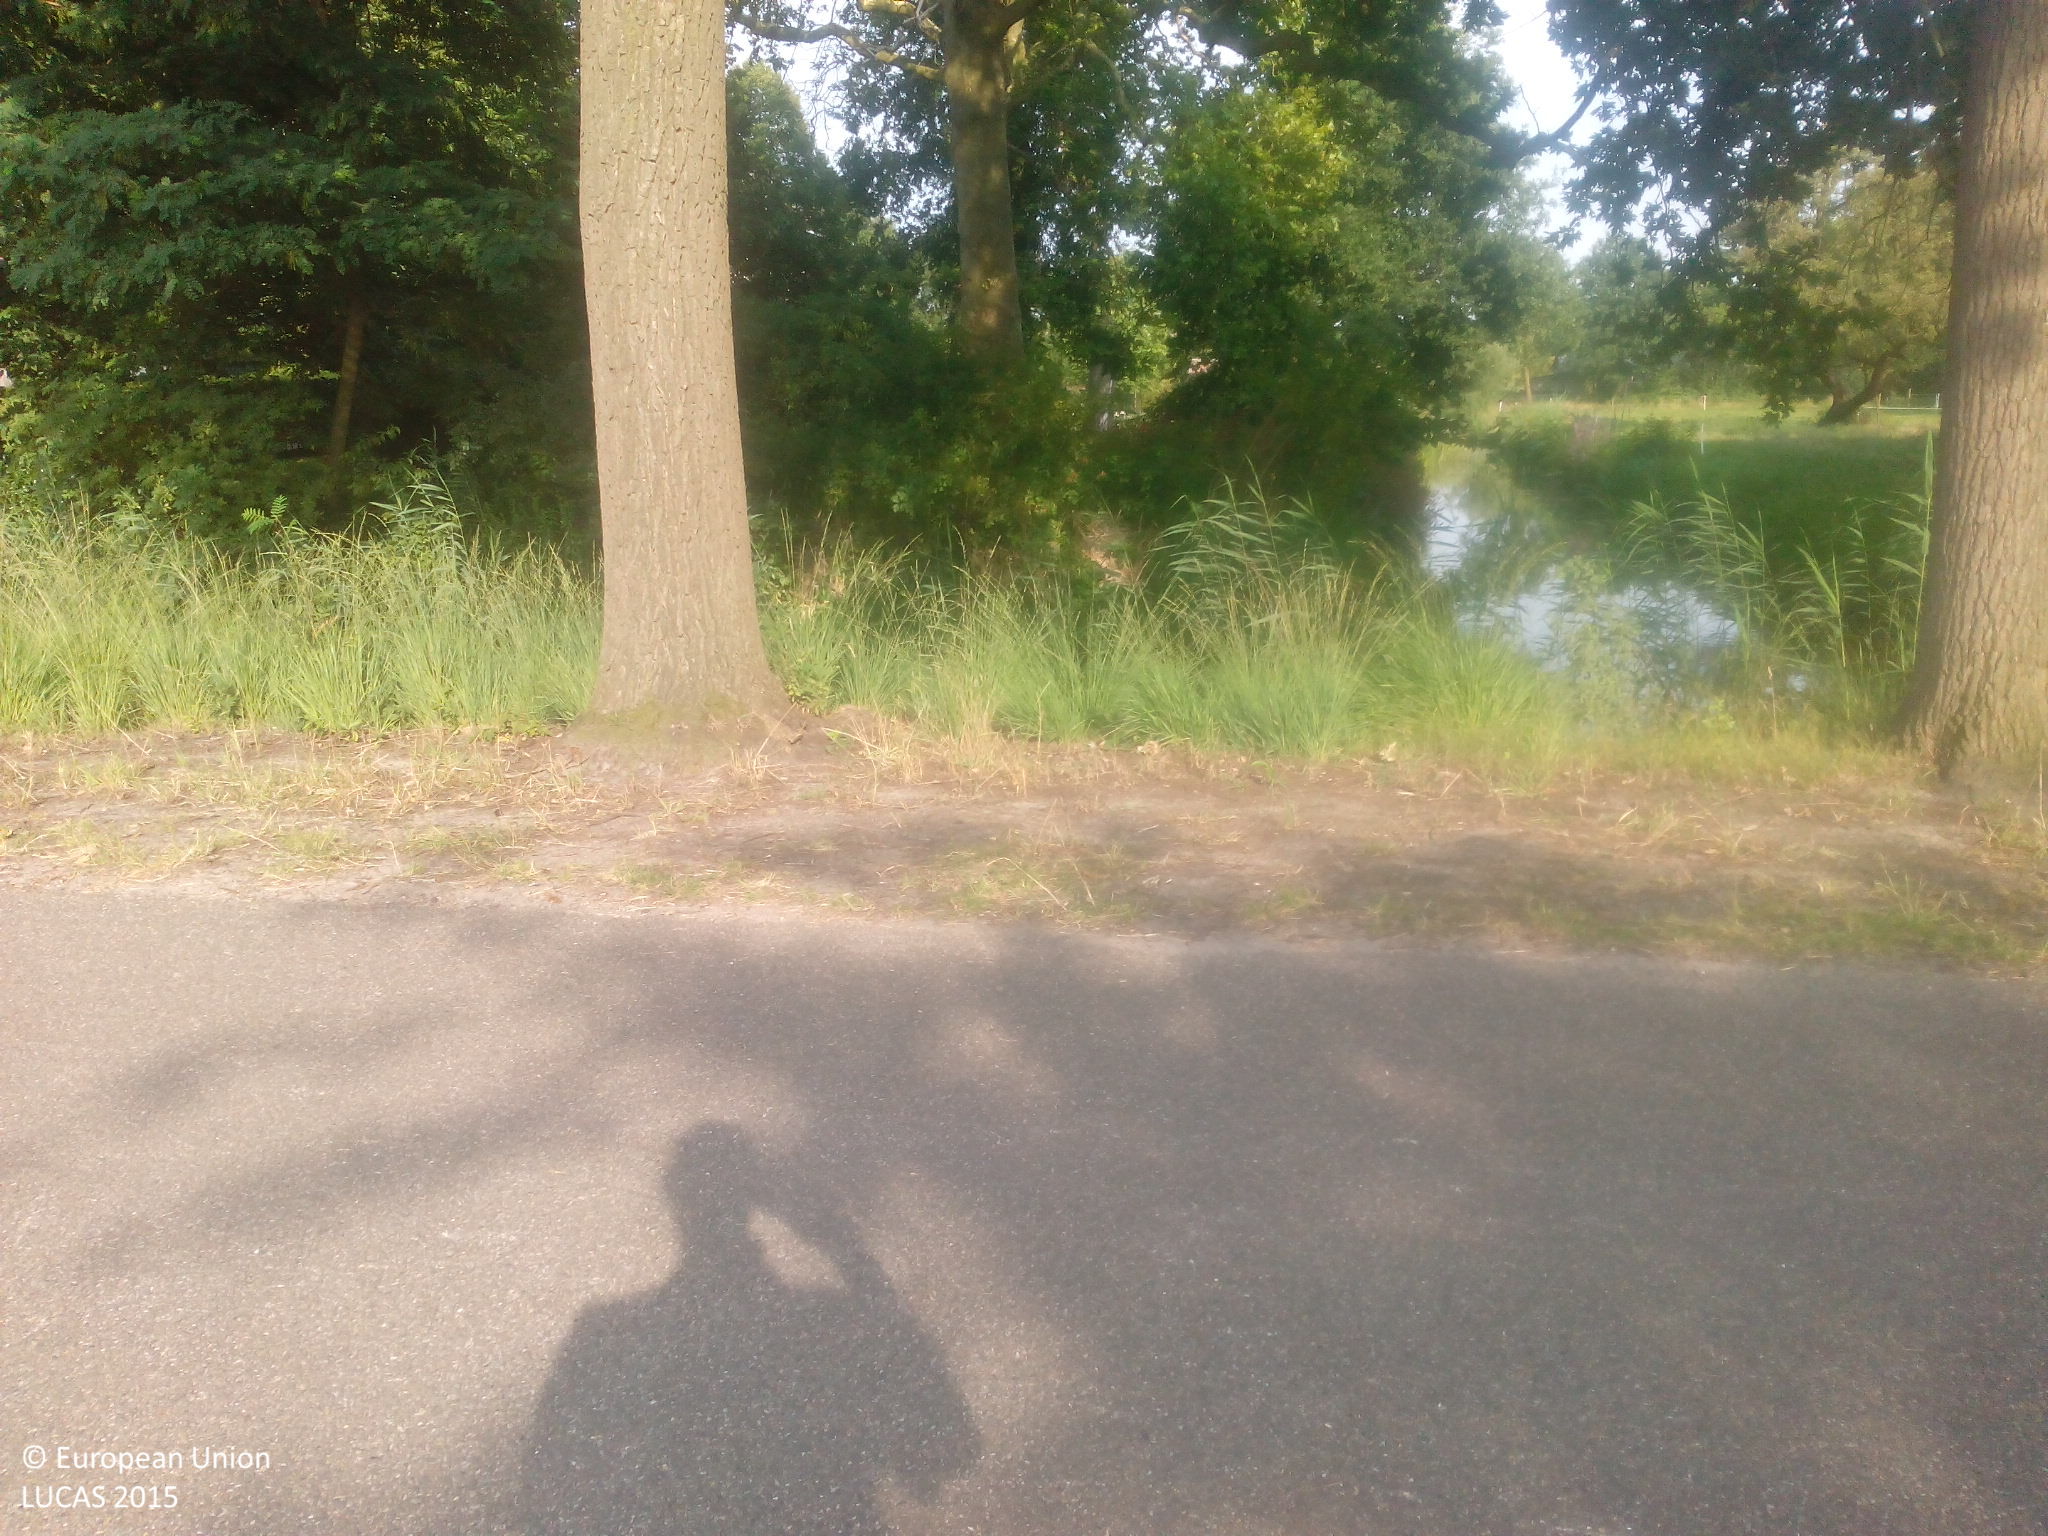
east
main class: Grassland
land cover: Grassland with sparse tree/shrub cover
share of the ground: > 75 %
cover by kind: herbaceous plants 95 %, broadleaved forest trees 5 %
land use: Residential
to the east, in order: Grassland with sparse tree/shrub cover; Inland fresh water bodies; Artificial constructions in urban areas; Sugar beet
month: August
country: NL
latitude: 51.7160
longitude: 5.4967
